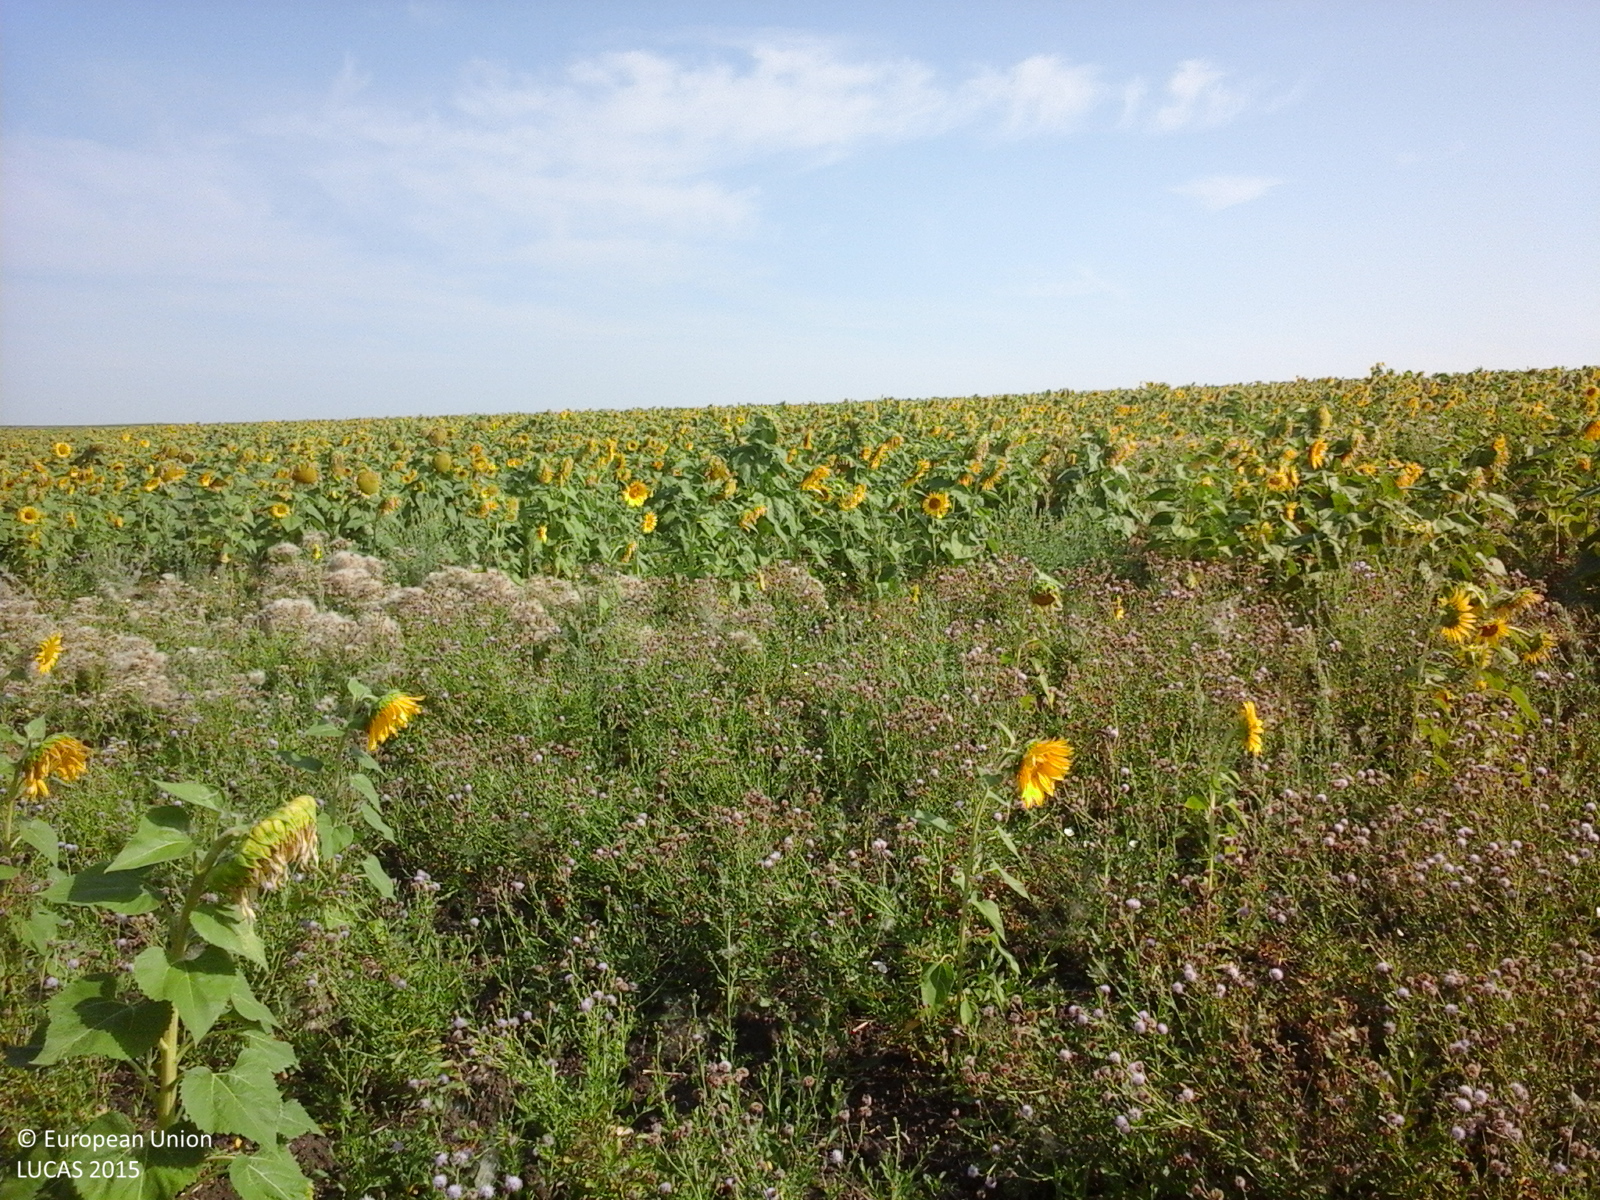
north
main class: Cropland
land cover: Sunflower
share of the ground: > 75 %
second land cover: Spontaneously vegetated surfaces
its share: 50 - 75 %
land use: Agriculture (excluding fallow land and kitchen gardens)
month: July
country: RO
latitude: 46.2529
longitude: 28.0663
